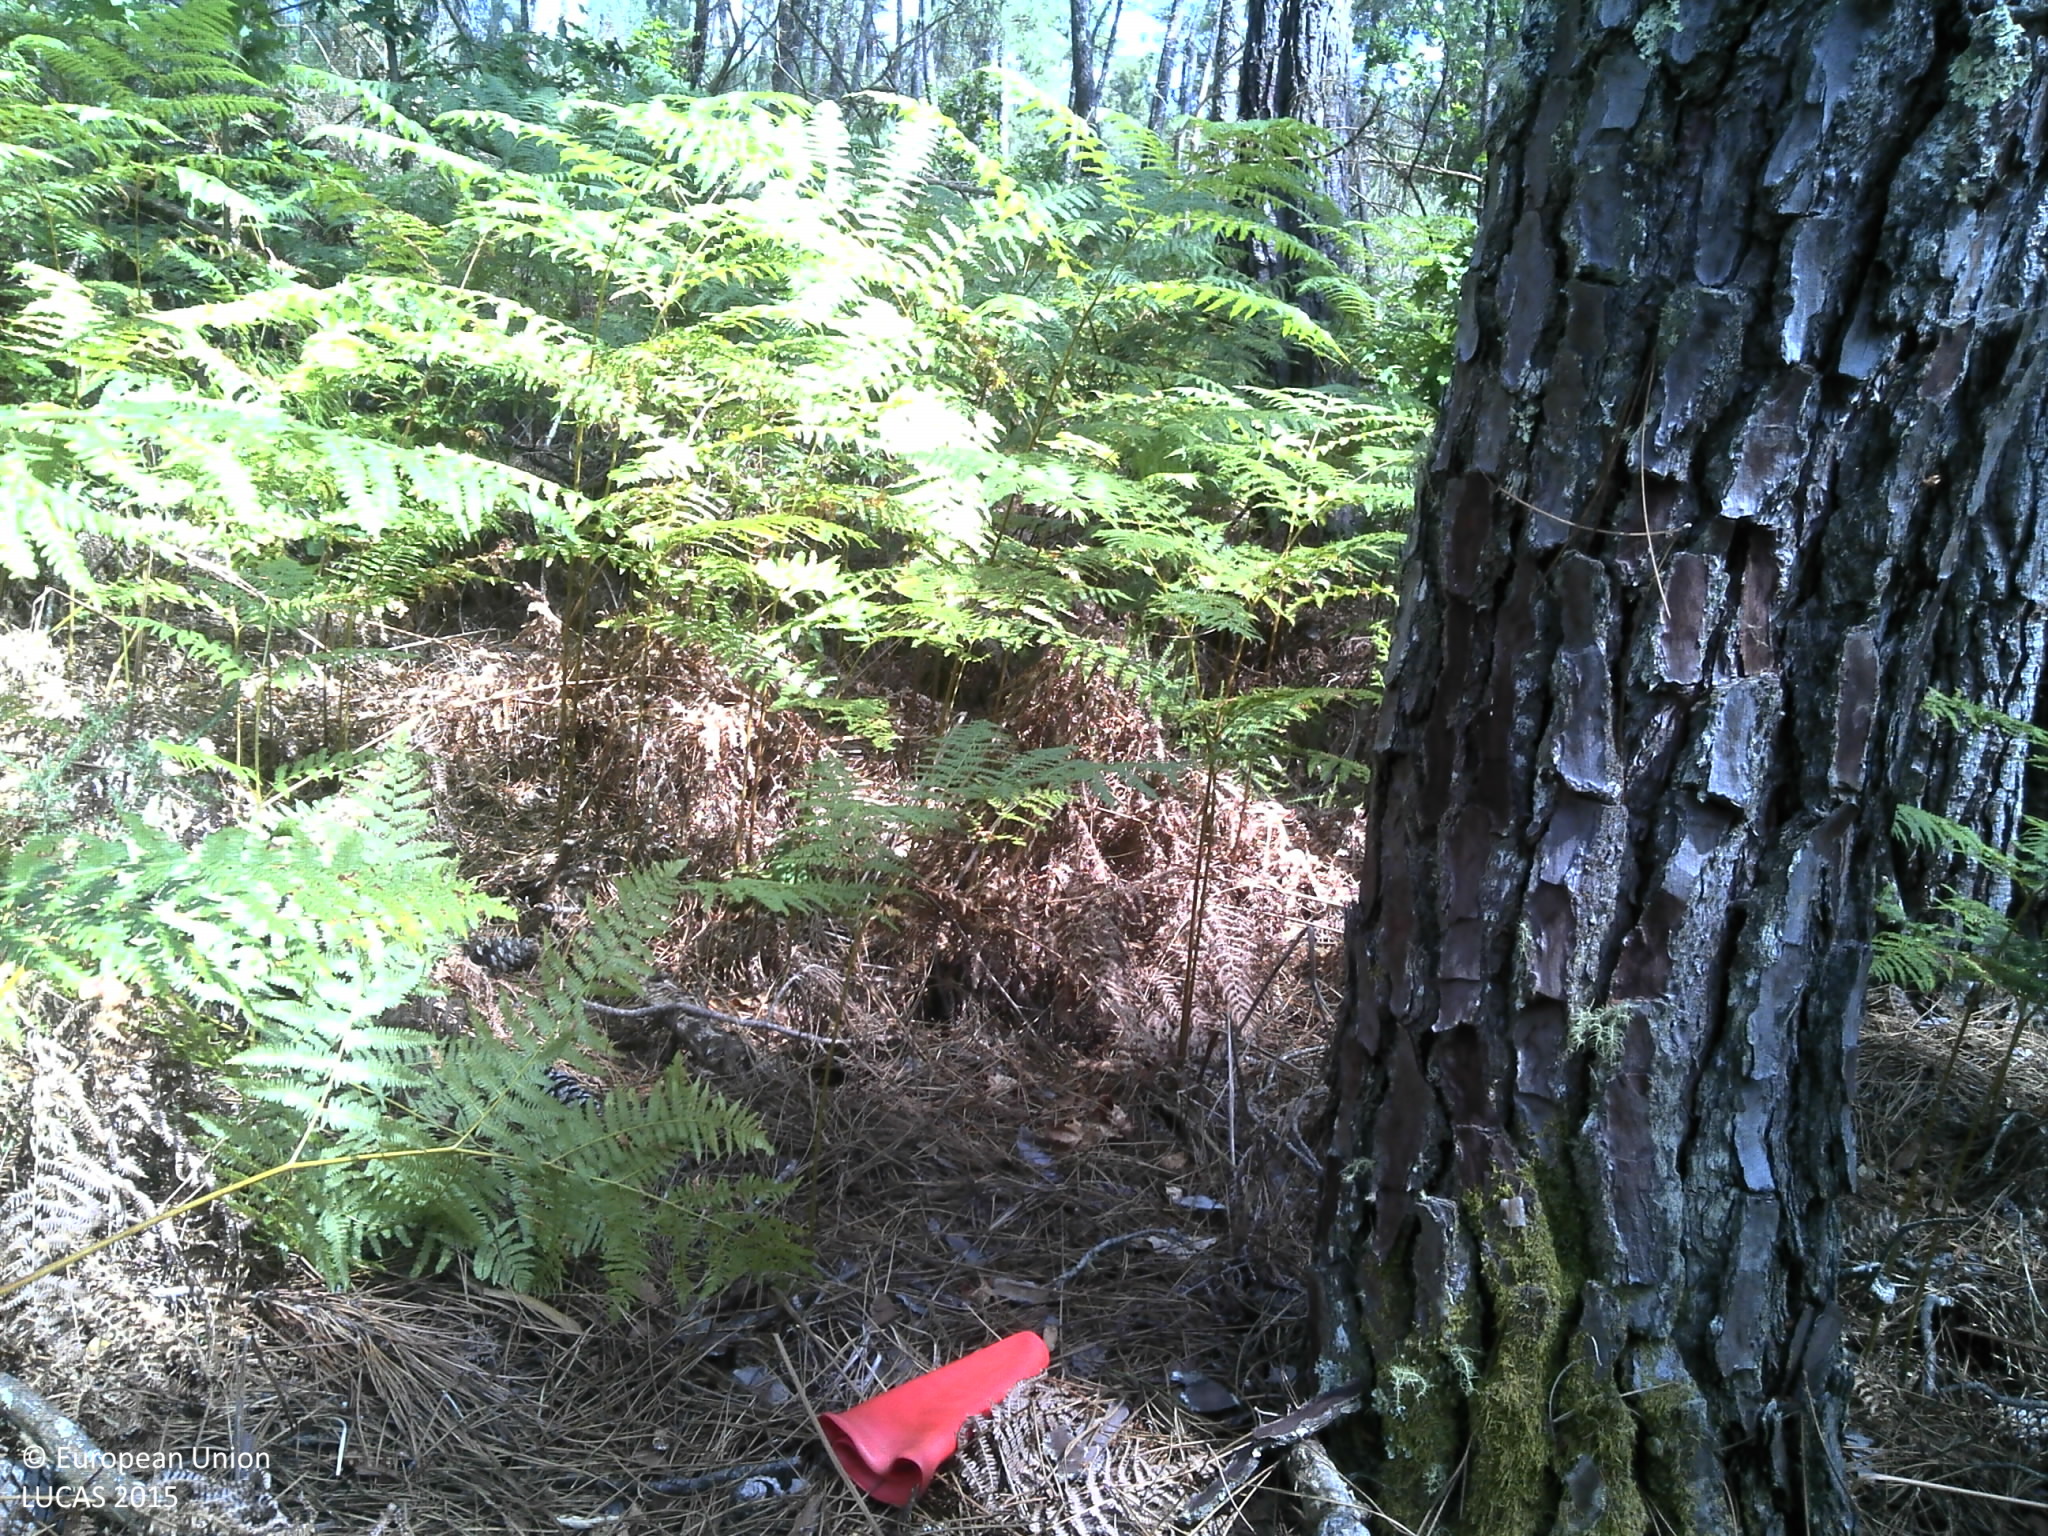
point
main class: Woodland
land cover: Pine dominated coniferous woodland
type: coniferous forest of the mediterranean region
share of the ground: 50 - 75 %
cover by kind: coniferous forest trees 60 %, shrubs 25 %, unconsolidated bare surface 15 %
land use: Forestry
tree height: > 5 m
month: June
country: PT
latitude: 40.8272
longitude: -7.9746
